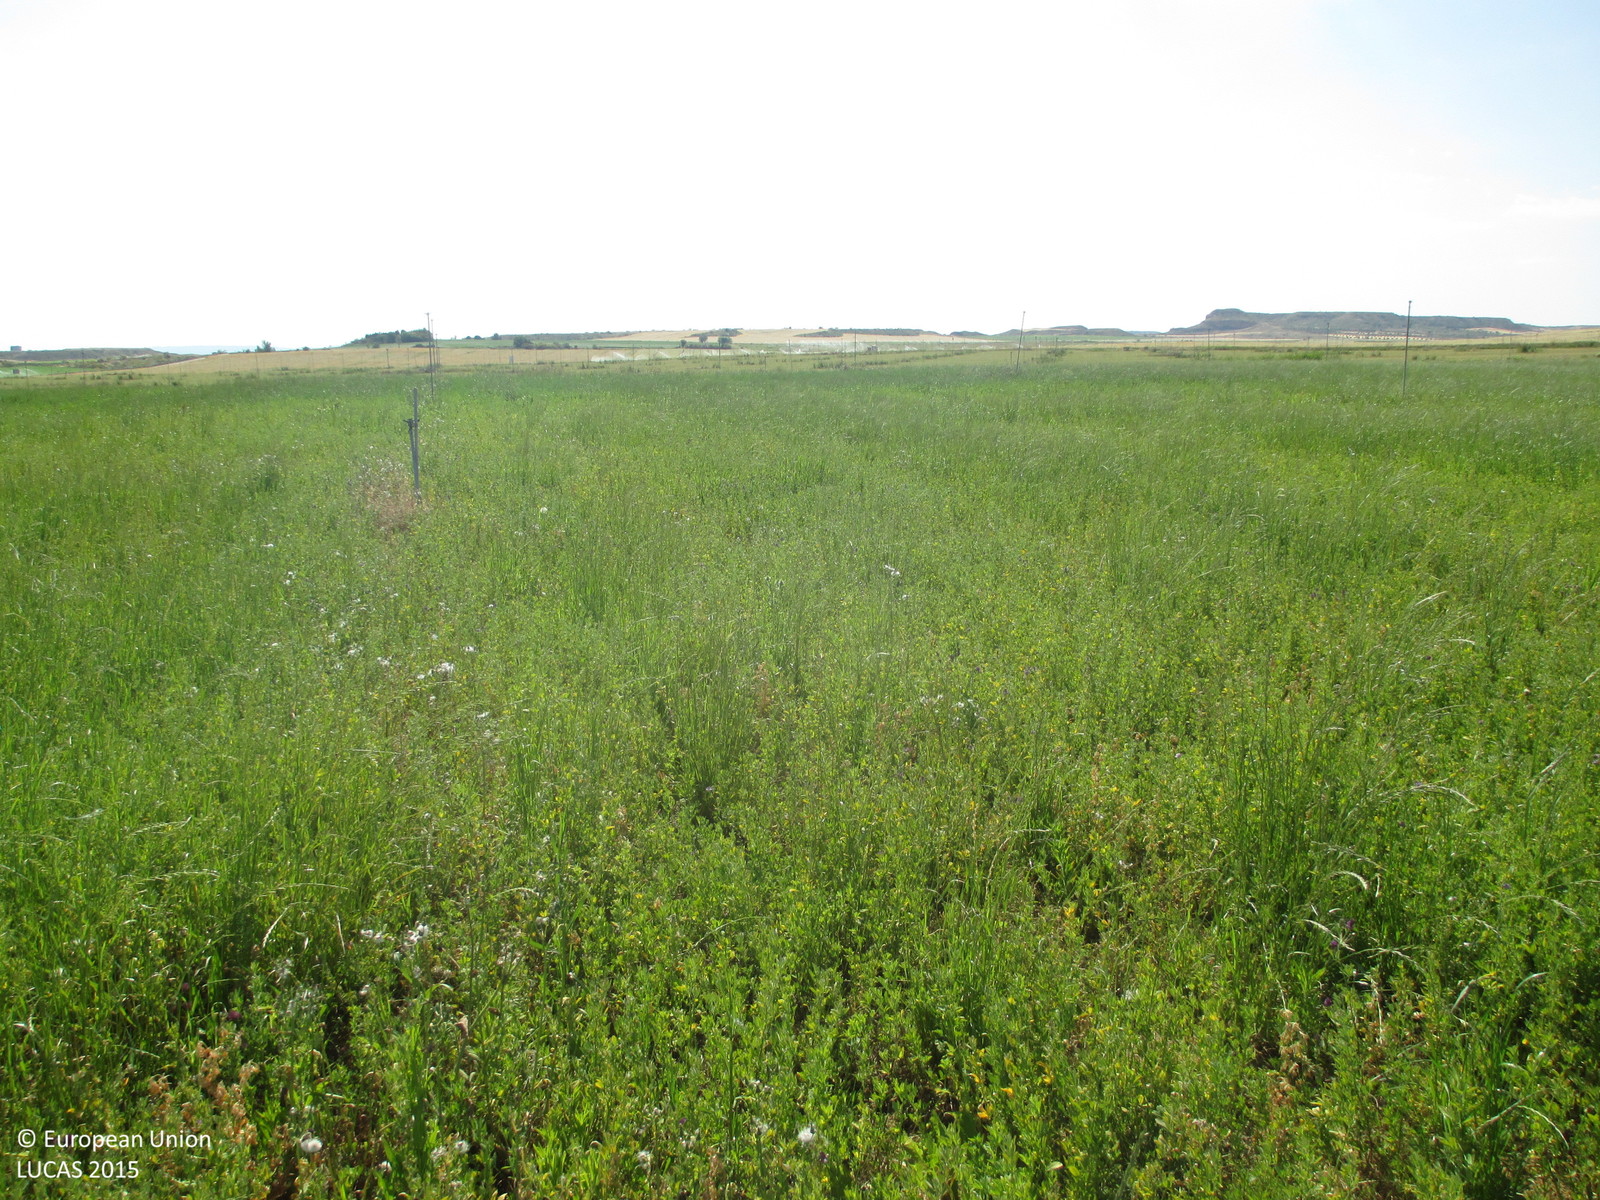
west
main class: Cropland
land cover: Lucerne
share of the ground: > 75 %
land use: Agriculture (excluding fallow land and kitchen gardens)
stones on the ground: < 10 %
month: May
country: ES
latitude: 41.9057
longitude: -0.1572
